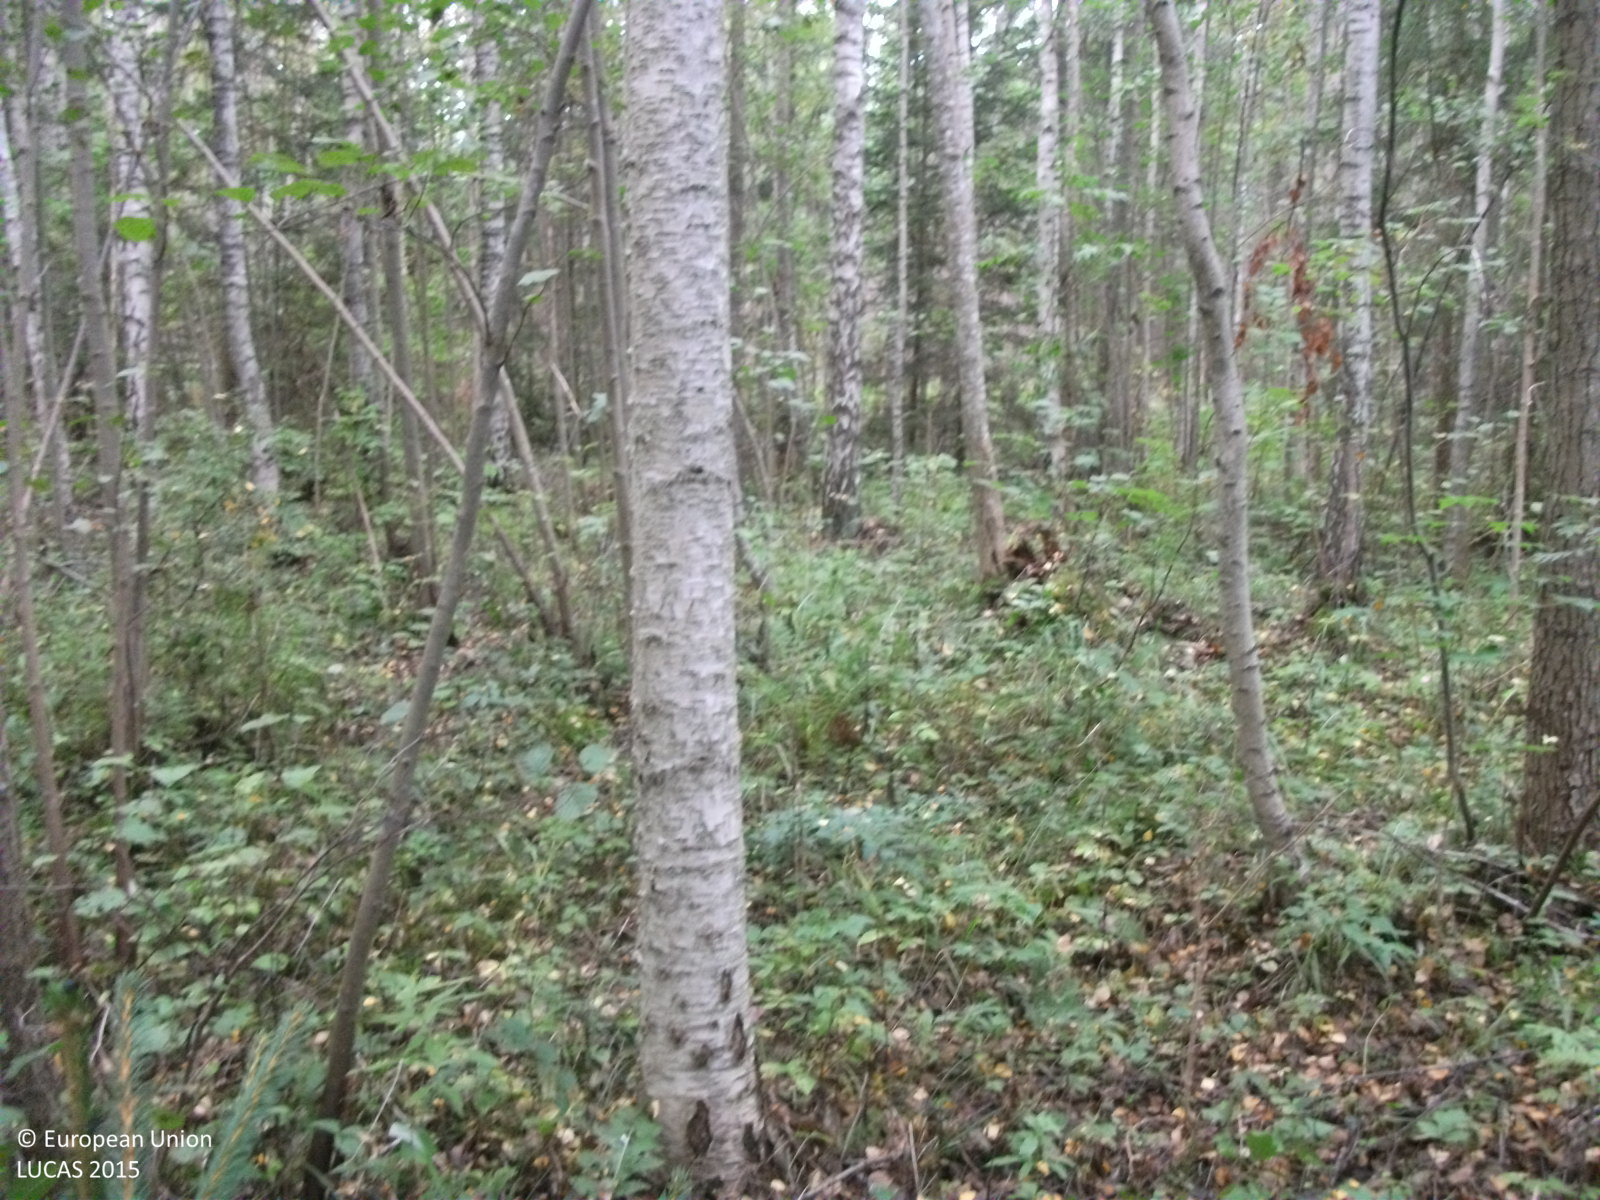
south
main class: Woodland
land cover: Broadleaved woodland
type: non-riverine alder, birch or aspen forest
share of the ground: > 75 %
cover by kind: broadleaved forest trees 85 %, herbaceous plants 10 %, shrubs 5 %
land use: Forestry
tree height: > 5 m
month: September
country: LV
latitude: 57.7088
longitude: 24.4381
